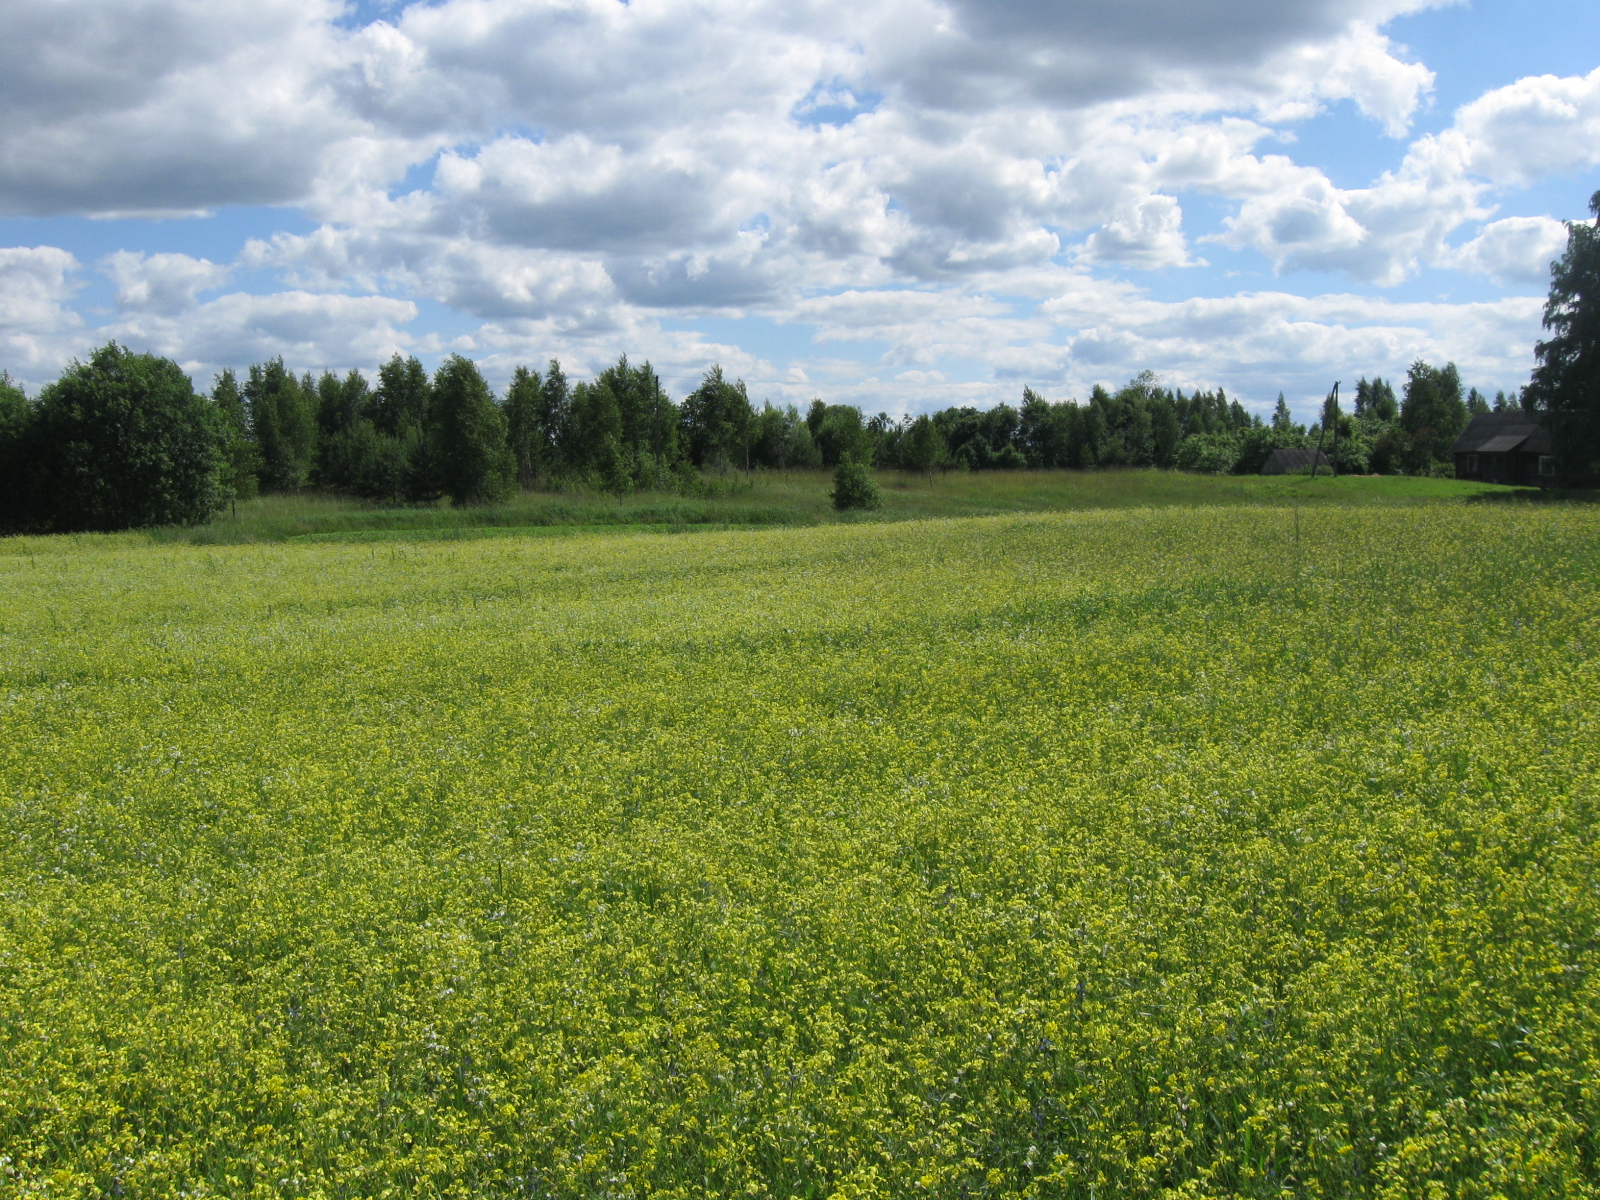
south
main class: Cropland
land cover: Dry pulses
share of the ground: > 75 %
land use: Agriculture (excluding fallow land and kitchen gardens)
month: June
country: LT
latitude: 54.5211
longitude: 24.6125
